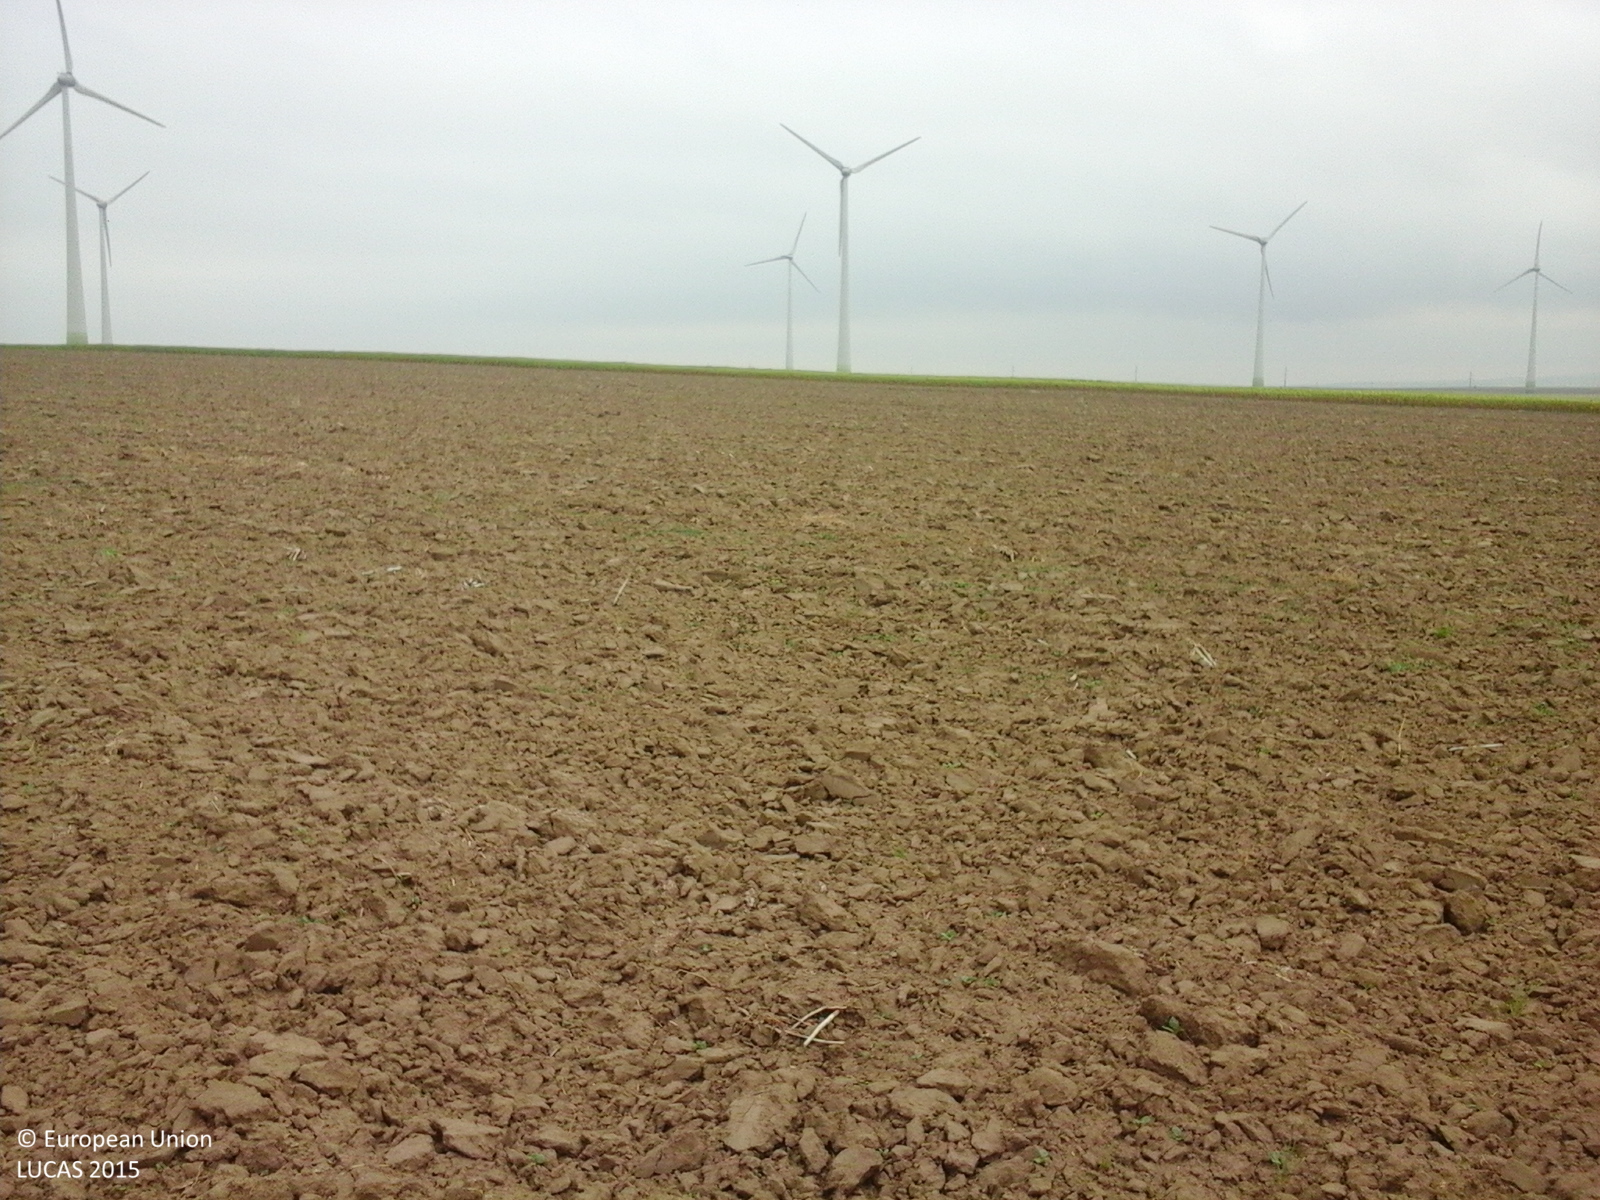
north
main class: Cropland
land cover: Rape and turnip rape
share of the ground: < 10 %
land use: Agriculture (excluding fallow land and kitchen gardens)
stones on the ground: < 10 %
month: August
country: RO
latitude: 44.8162
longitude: 28.2656
